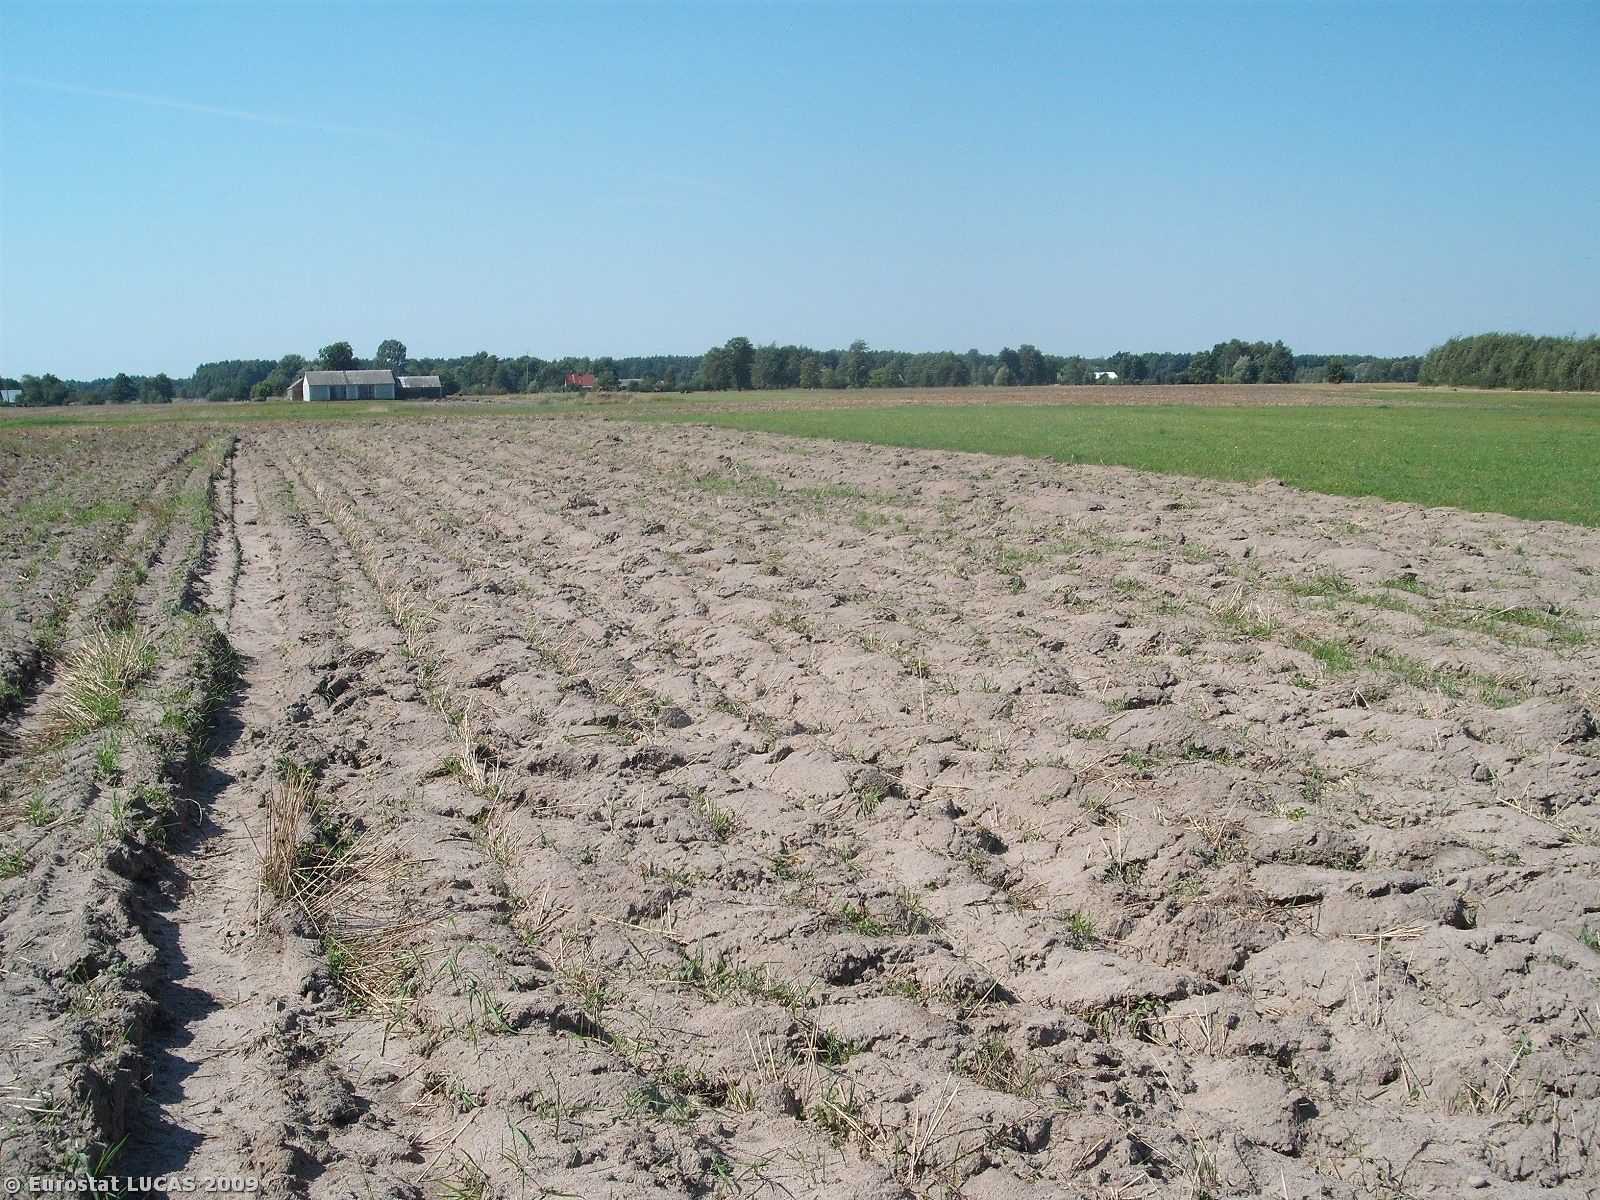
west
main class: Cropland
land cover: Triticale
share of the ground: < 10 %
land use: Agriculture (excluding fallow land and kitchen gardens)
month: September
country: PL
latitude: 52.4338
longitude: 21.6882
